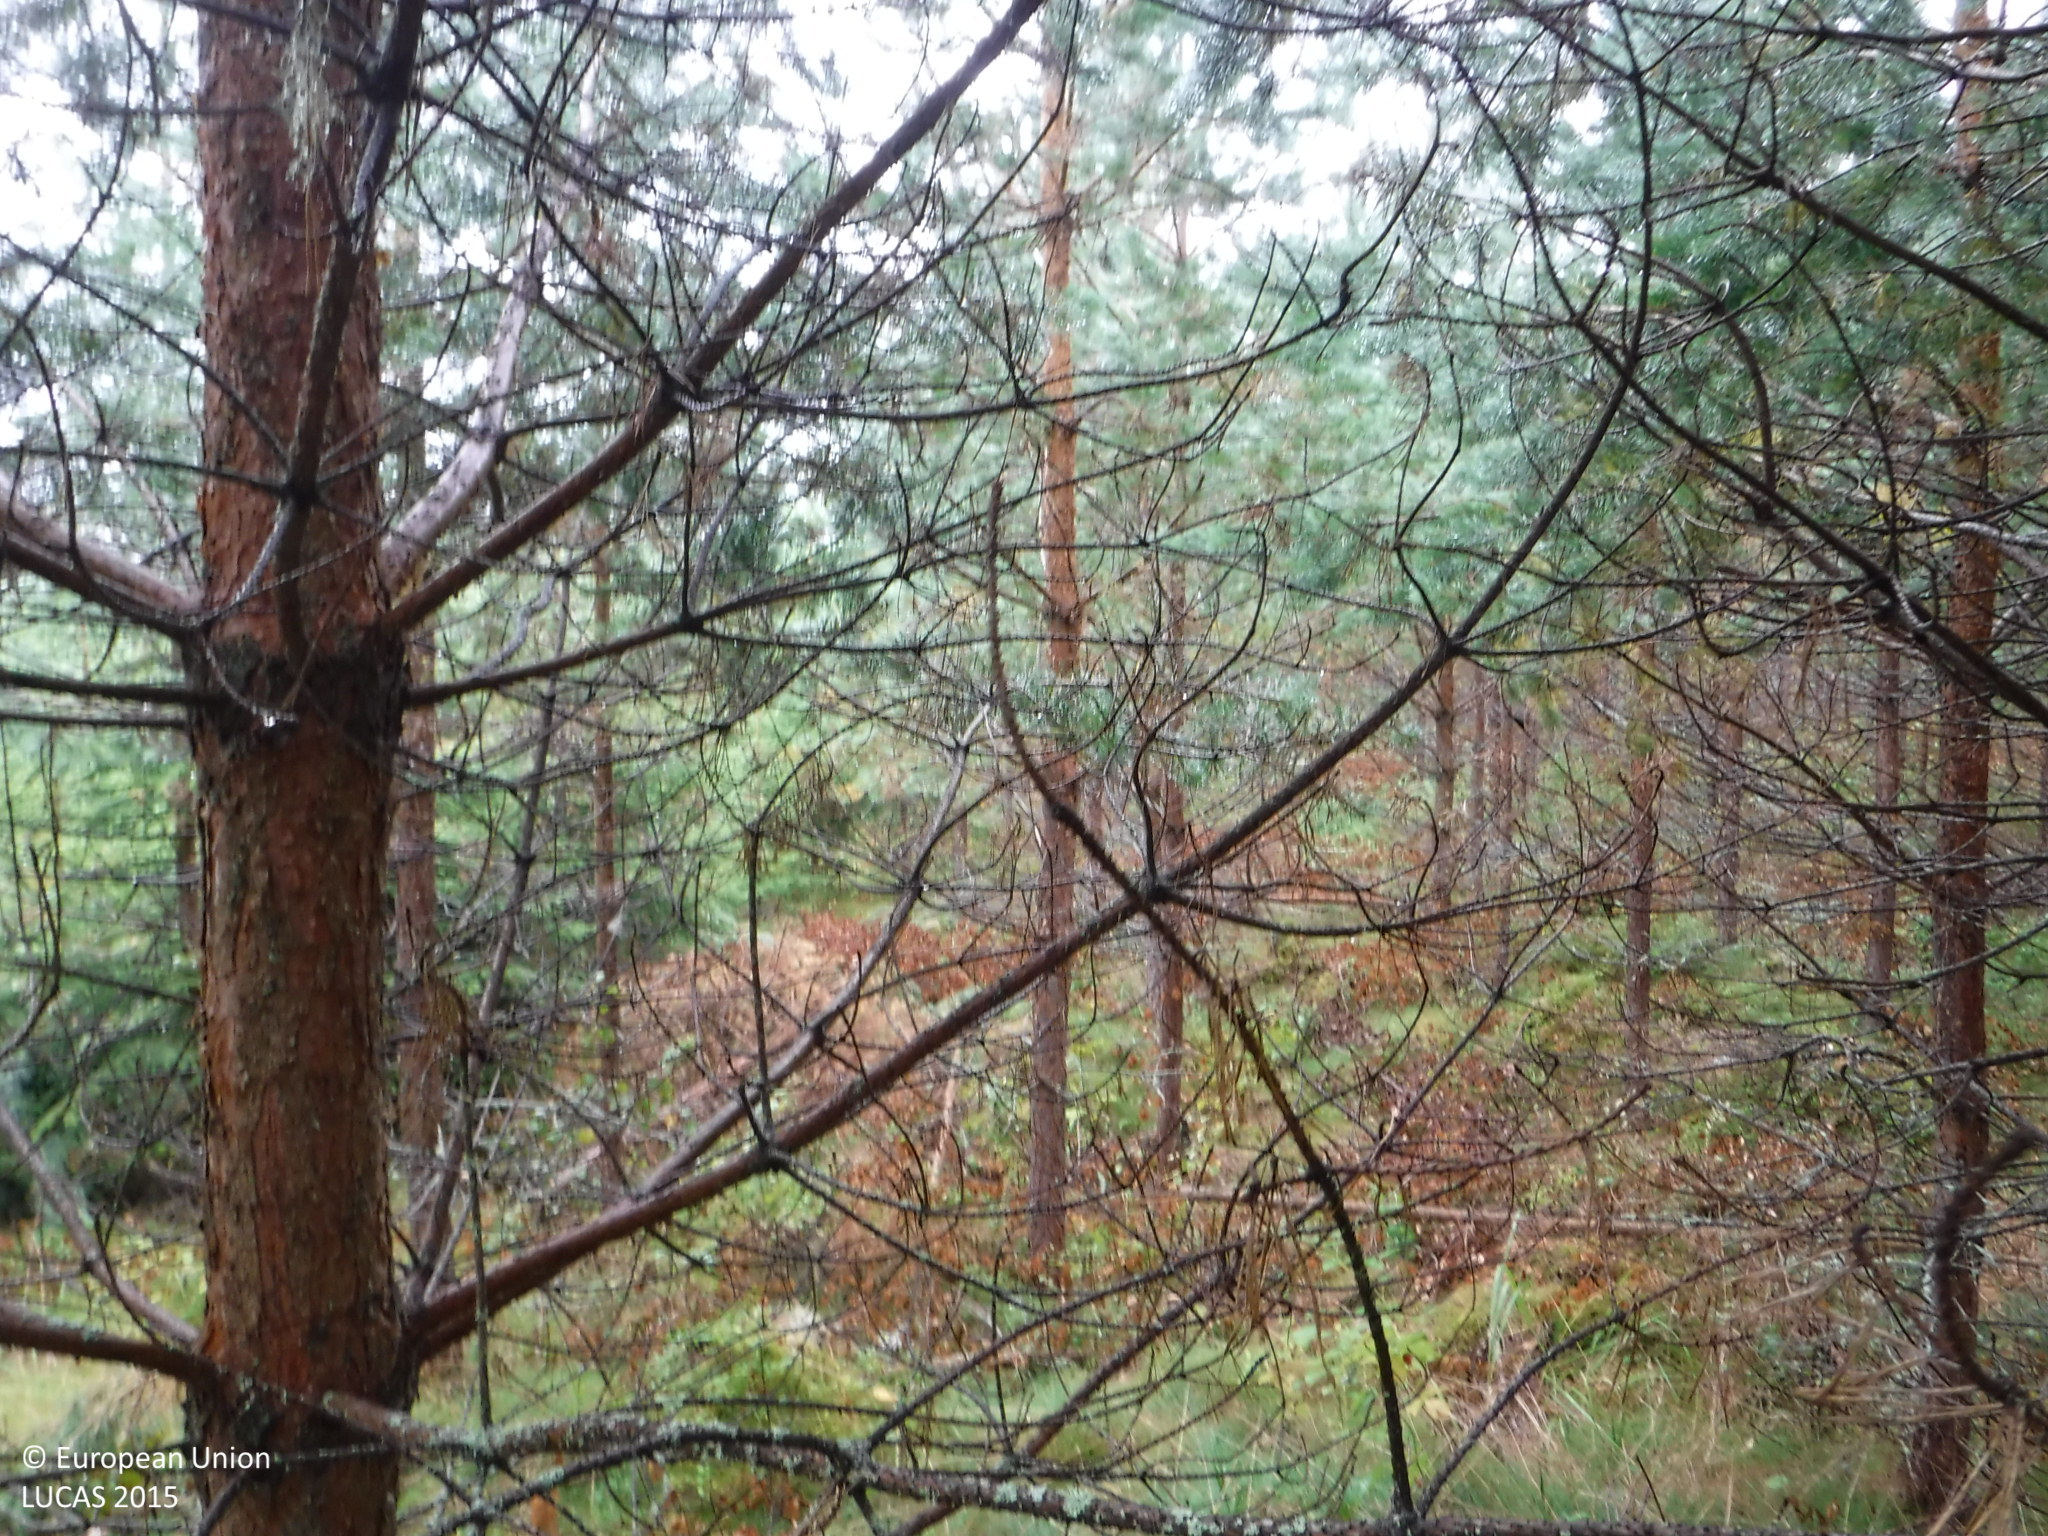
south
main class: Woodland
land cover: Pine dominated coniferous woodland
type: boreal forest
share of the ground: 50 - 75 %
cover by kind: coniferous forest trees 65 %, herbaceous plants 25 %, broadleaved forest trees 5 %, shrubs 5 %
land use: Forestry
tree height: > 5 m
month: August
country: FI
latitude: 61.2337
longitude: 22.8682
